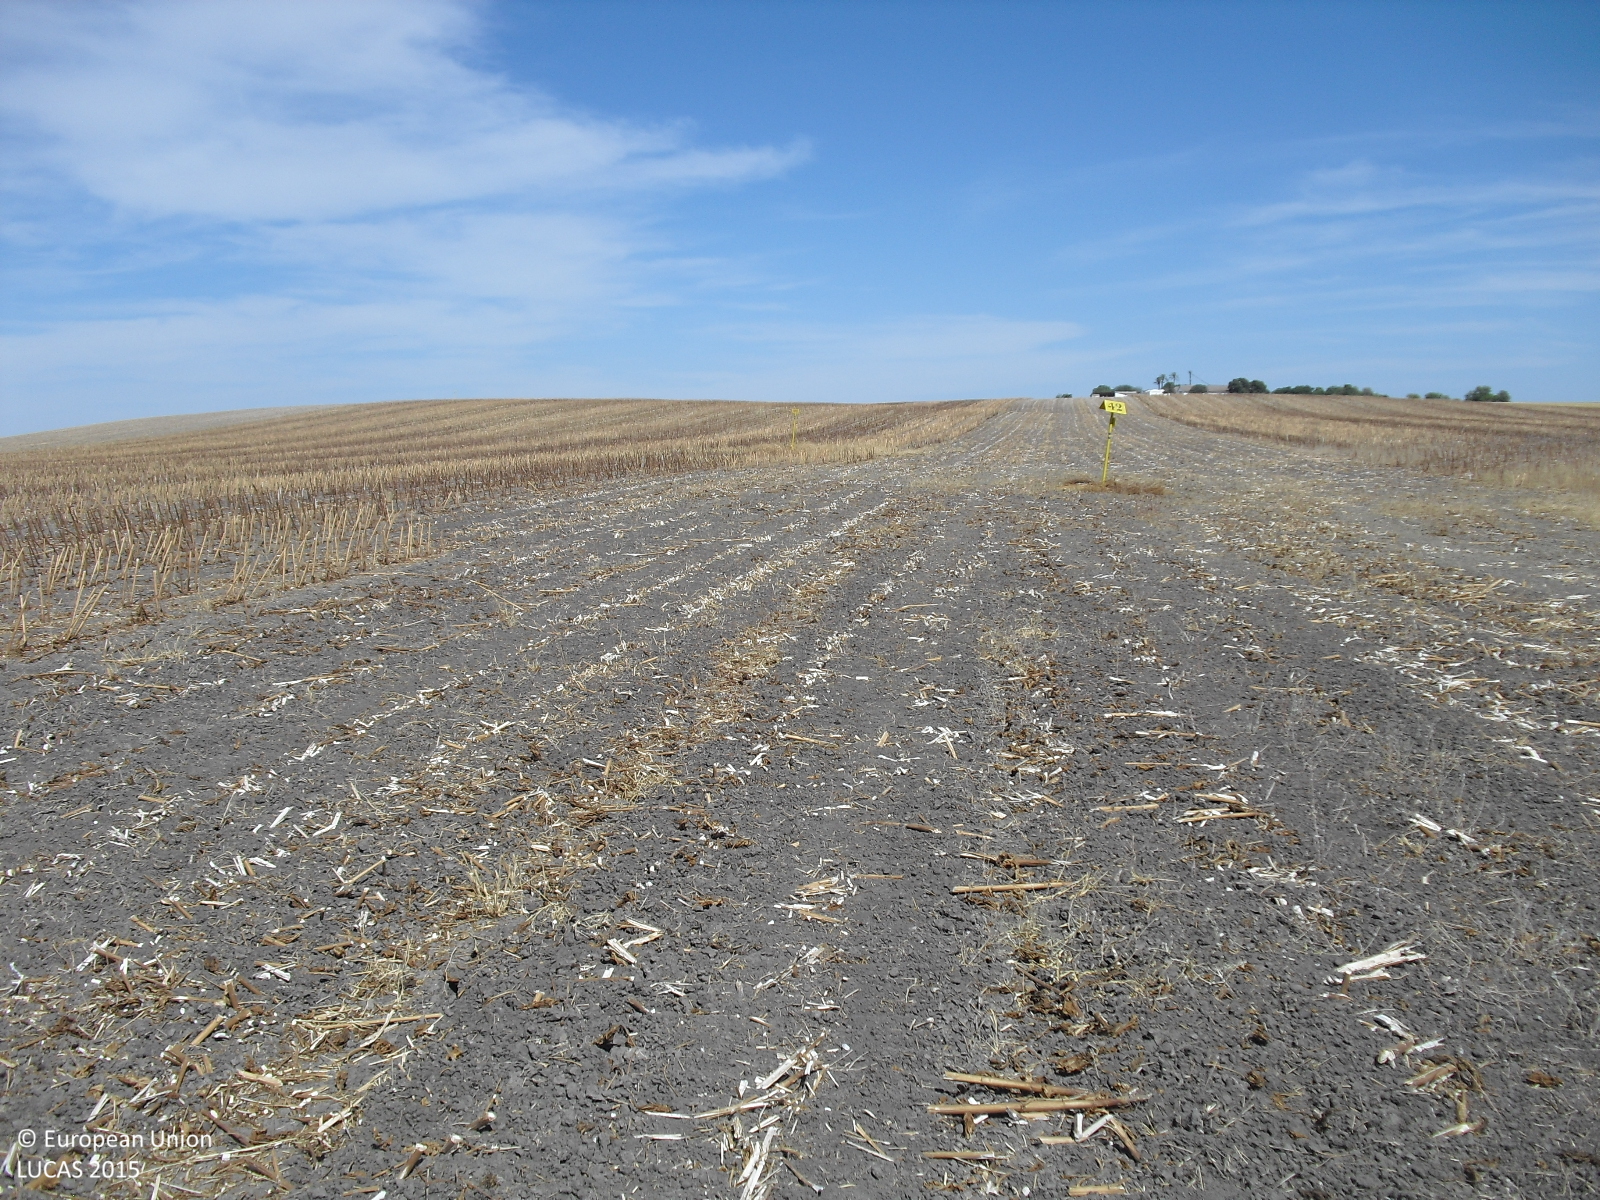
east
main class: Cropland
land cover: Sunflower
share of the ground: < 10 %
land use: Agriculture (excluding fallow land and kitchen gardens)
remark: Harvested field
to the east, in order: Sunflower
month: August
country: ES
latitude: 37.3604
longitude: -5.5634
